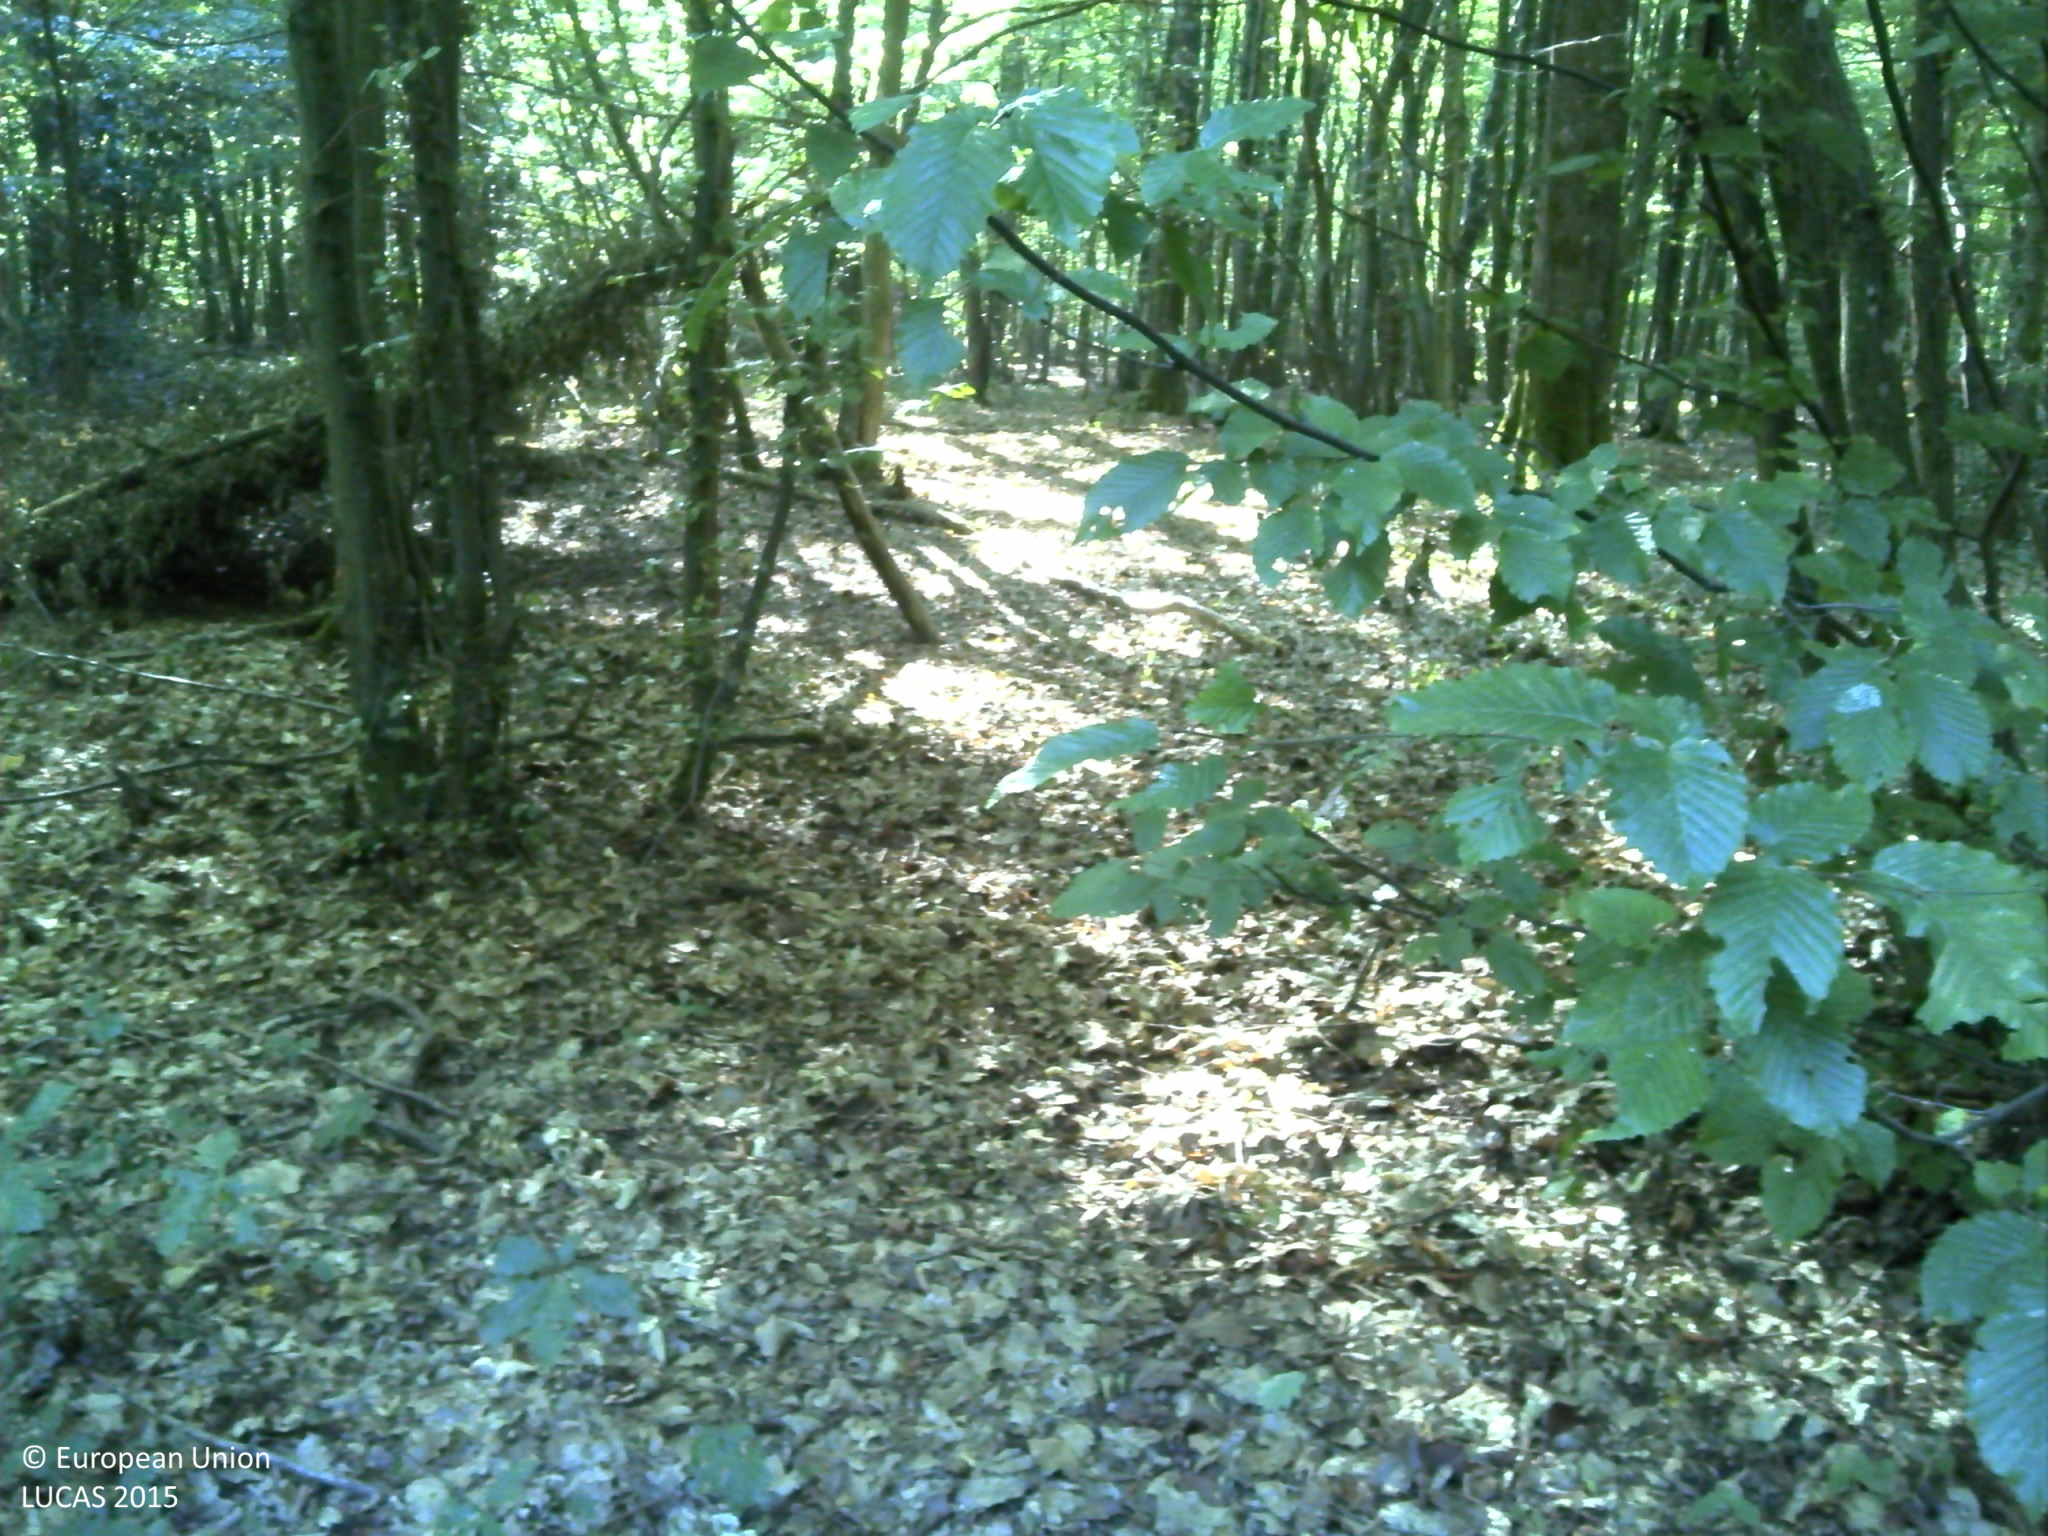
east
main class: Woodland
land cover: Broadleaved woodland
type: mesophytic deciduous forest
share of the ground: > 75 %
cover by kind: broadleaved forest trees 80 %, shrubs 15 %, herbaceous plants 5 %
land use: Forestry
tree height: > 5 m
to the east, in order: Broadleaved woodland; Ditches and canals; Tracks; Broadleaved woodland; Fences; Broadleaved woodland; Grassland without tree/shrub cover
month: August
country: FR
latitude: 48.7166
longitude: 1.8436
